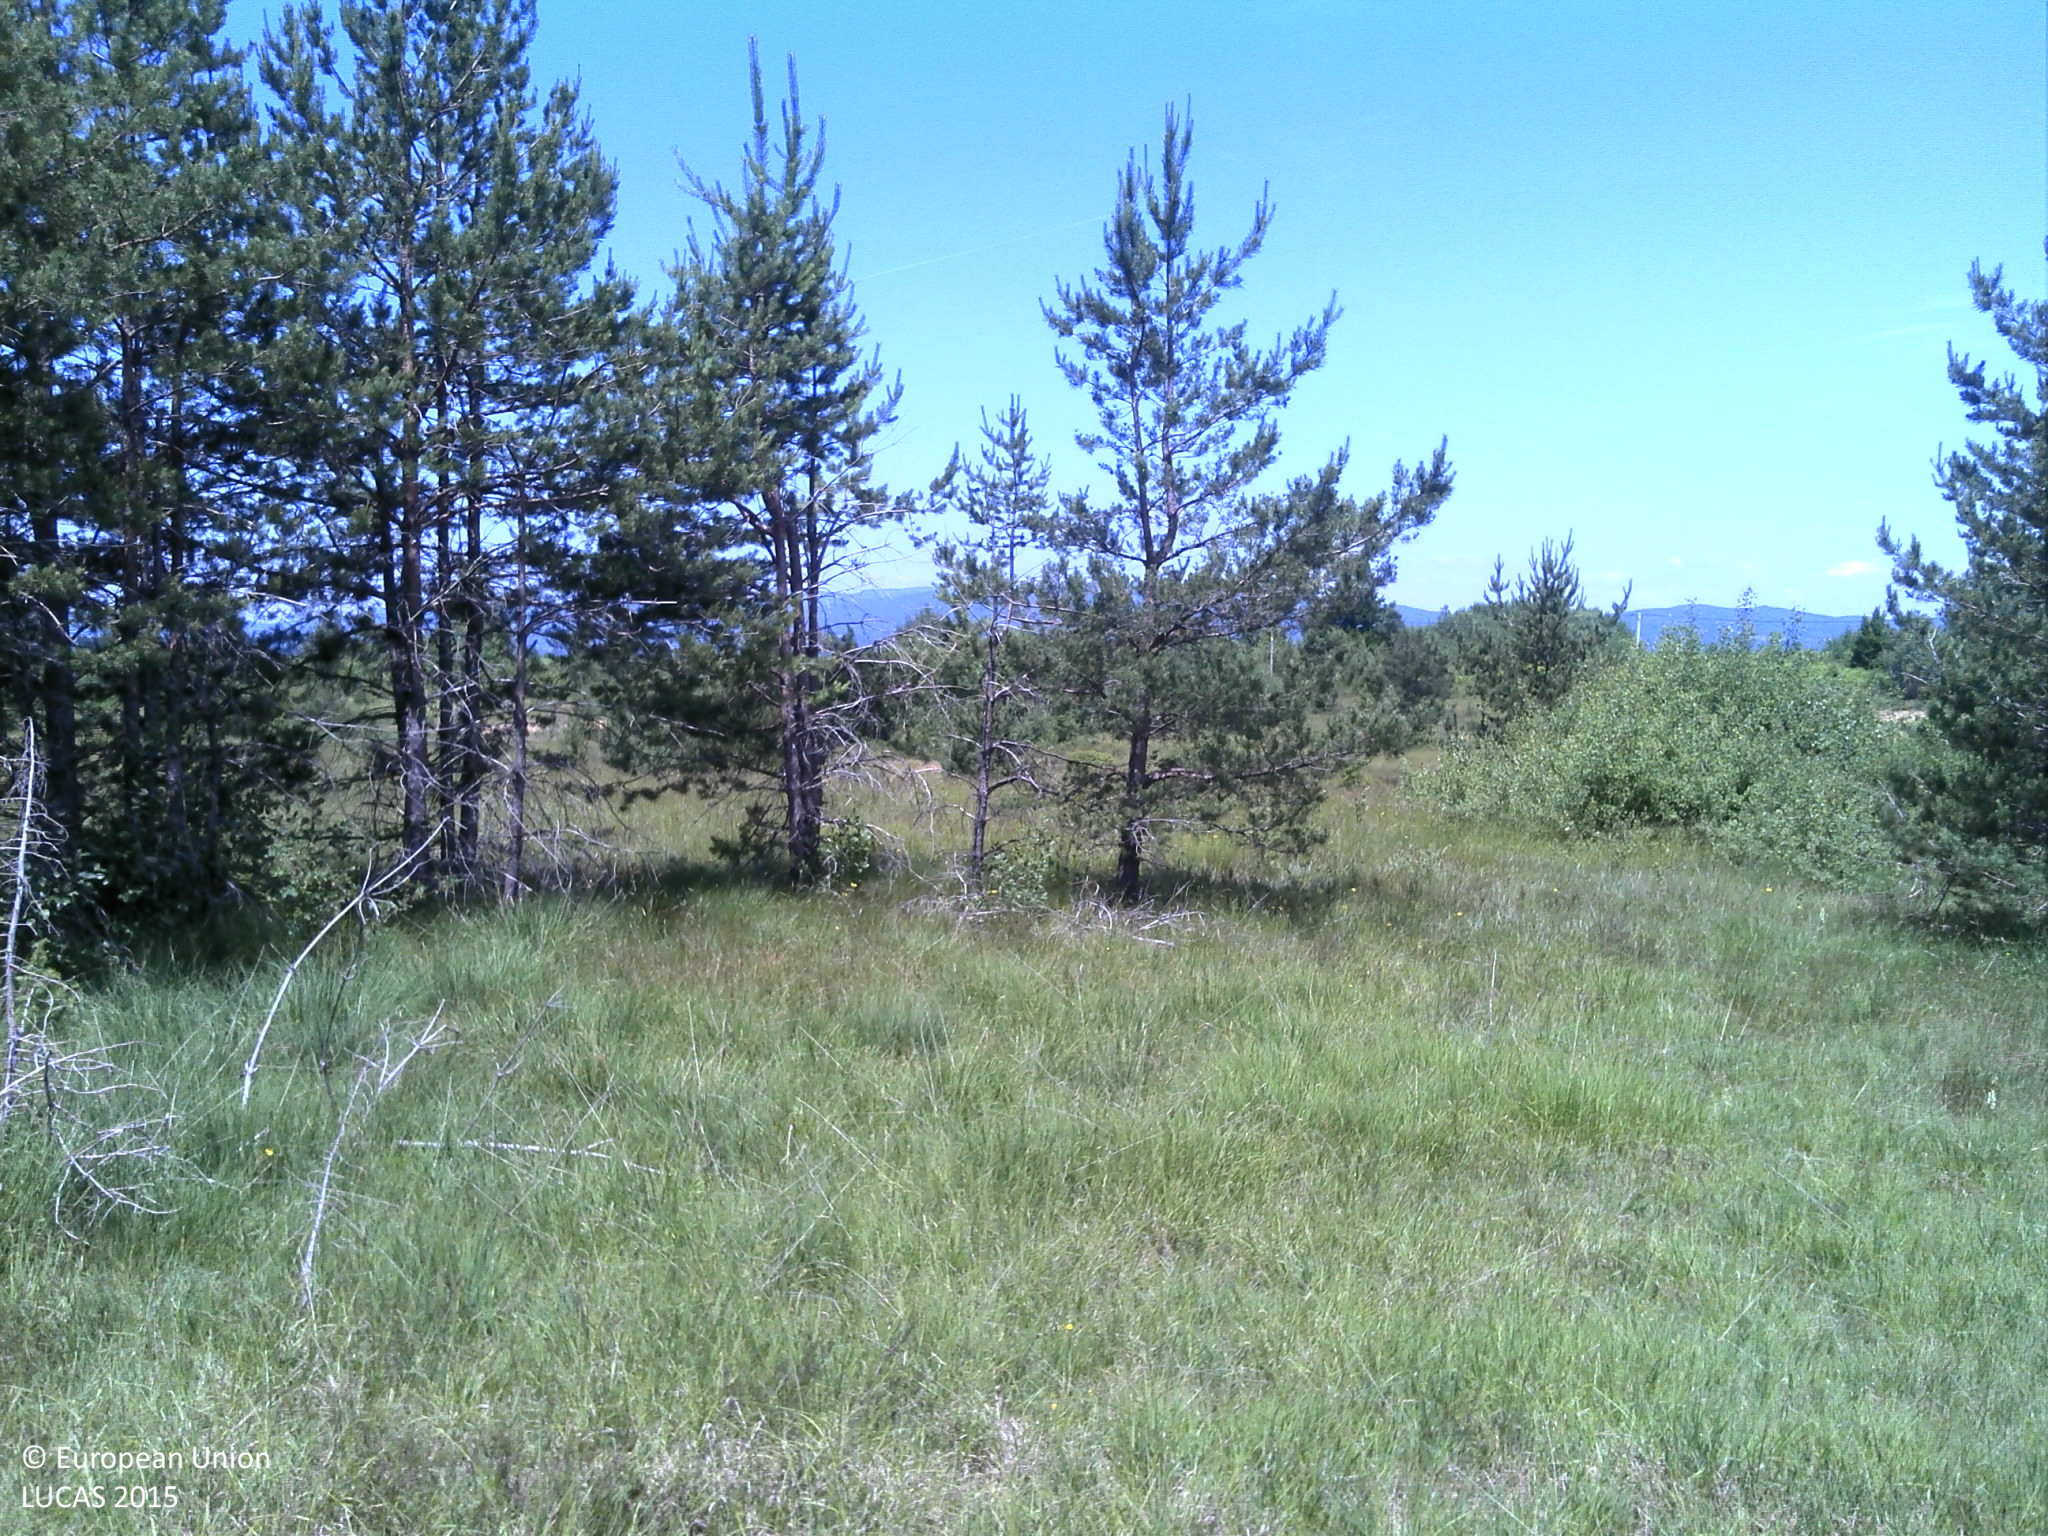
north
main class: Woodland
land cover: Pine dominated coniferous woodland
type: coniferous forest of the mediterranean region
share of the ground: 10 - 25 %
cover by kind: herbaceous plants 75 %, coniferous forest trees 25 %
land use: Semi-natural and natural areas not in use
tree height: > 5 m
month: June
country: HR
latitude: 44.4365
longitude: 15.5587
